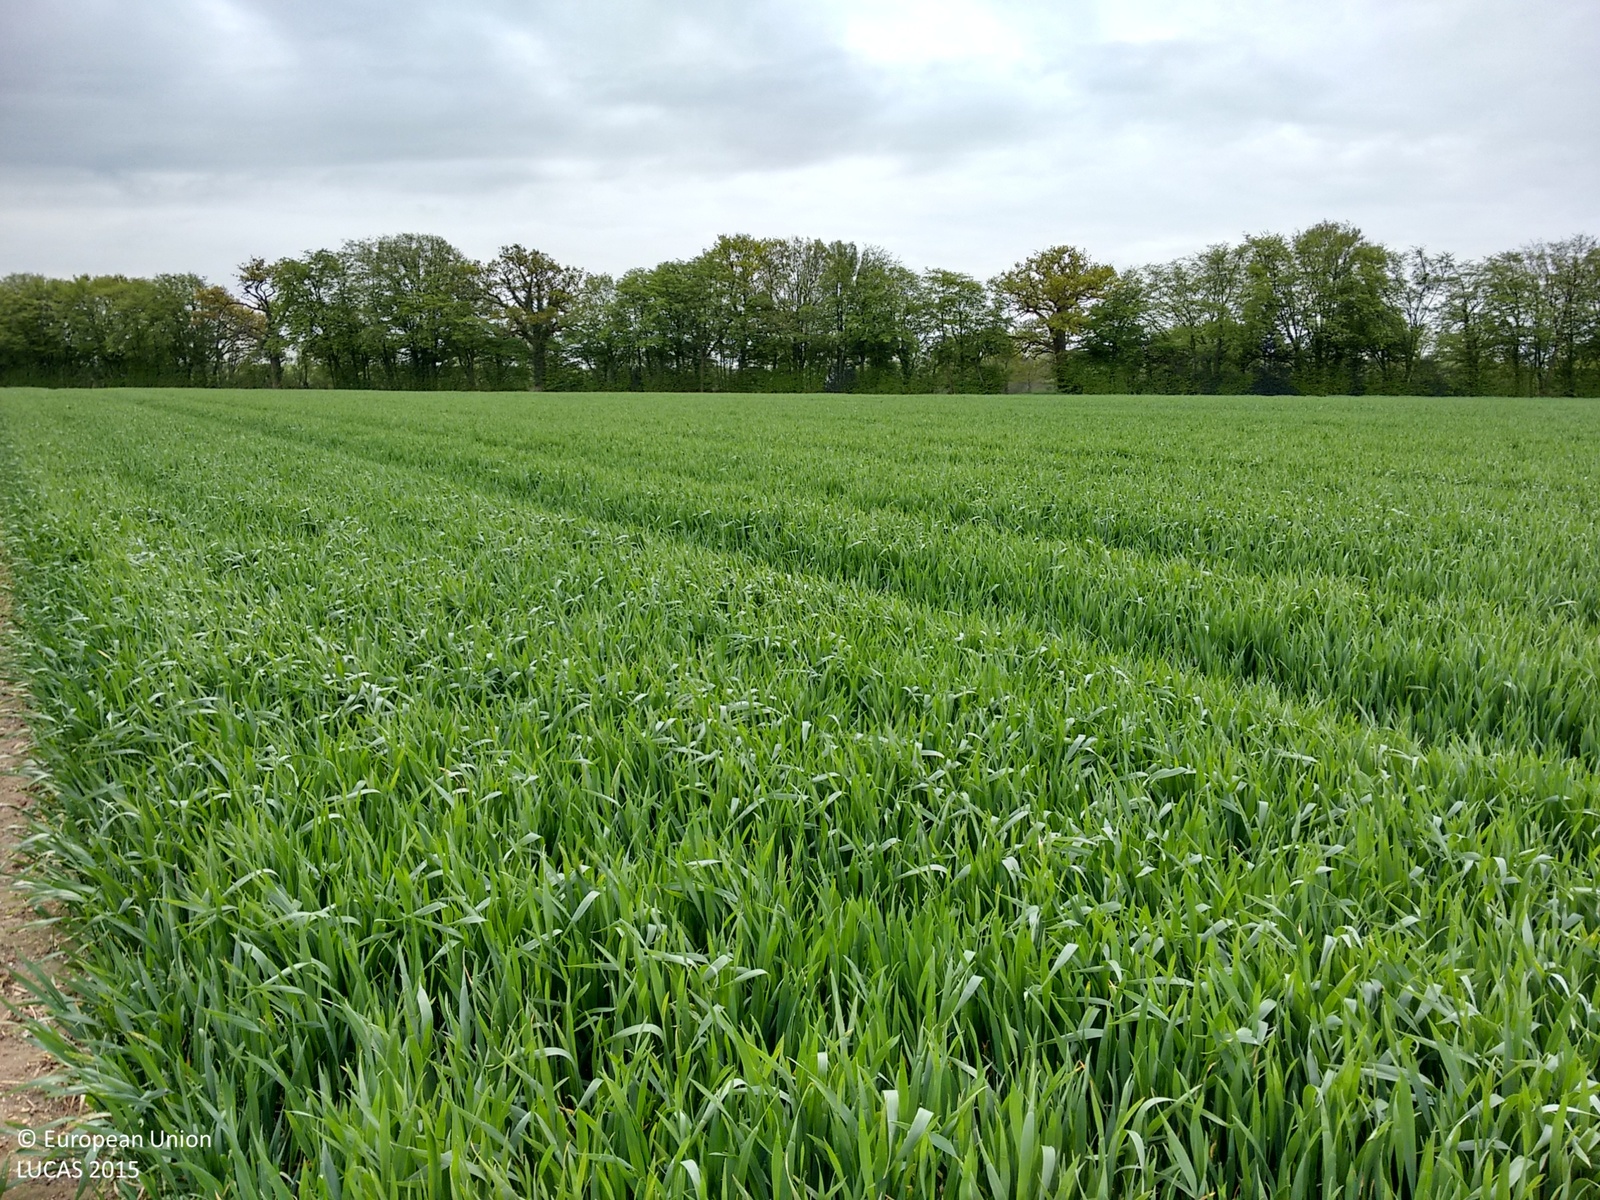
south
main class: Cropland
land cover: Common wheat
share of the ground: > 75 %
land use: Agriculture (excluding fallow land and kitchen gardens)
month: May
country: GB
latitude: 51.7563
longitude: -0.6006
